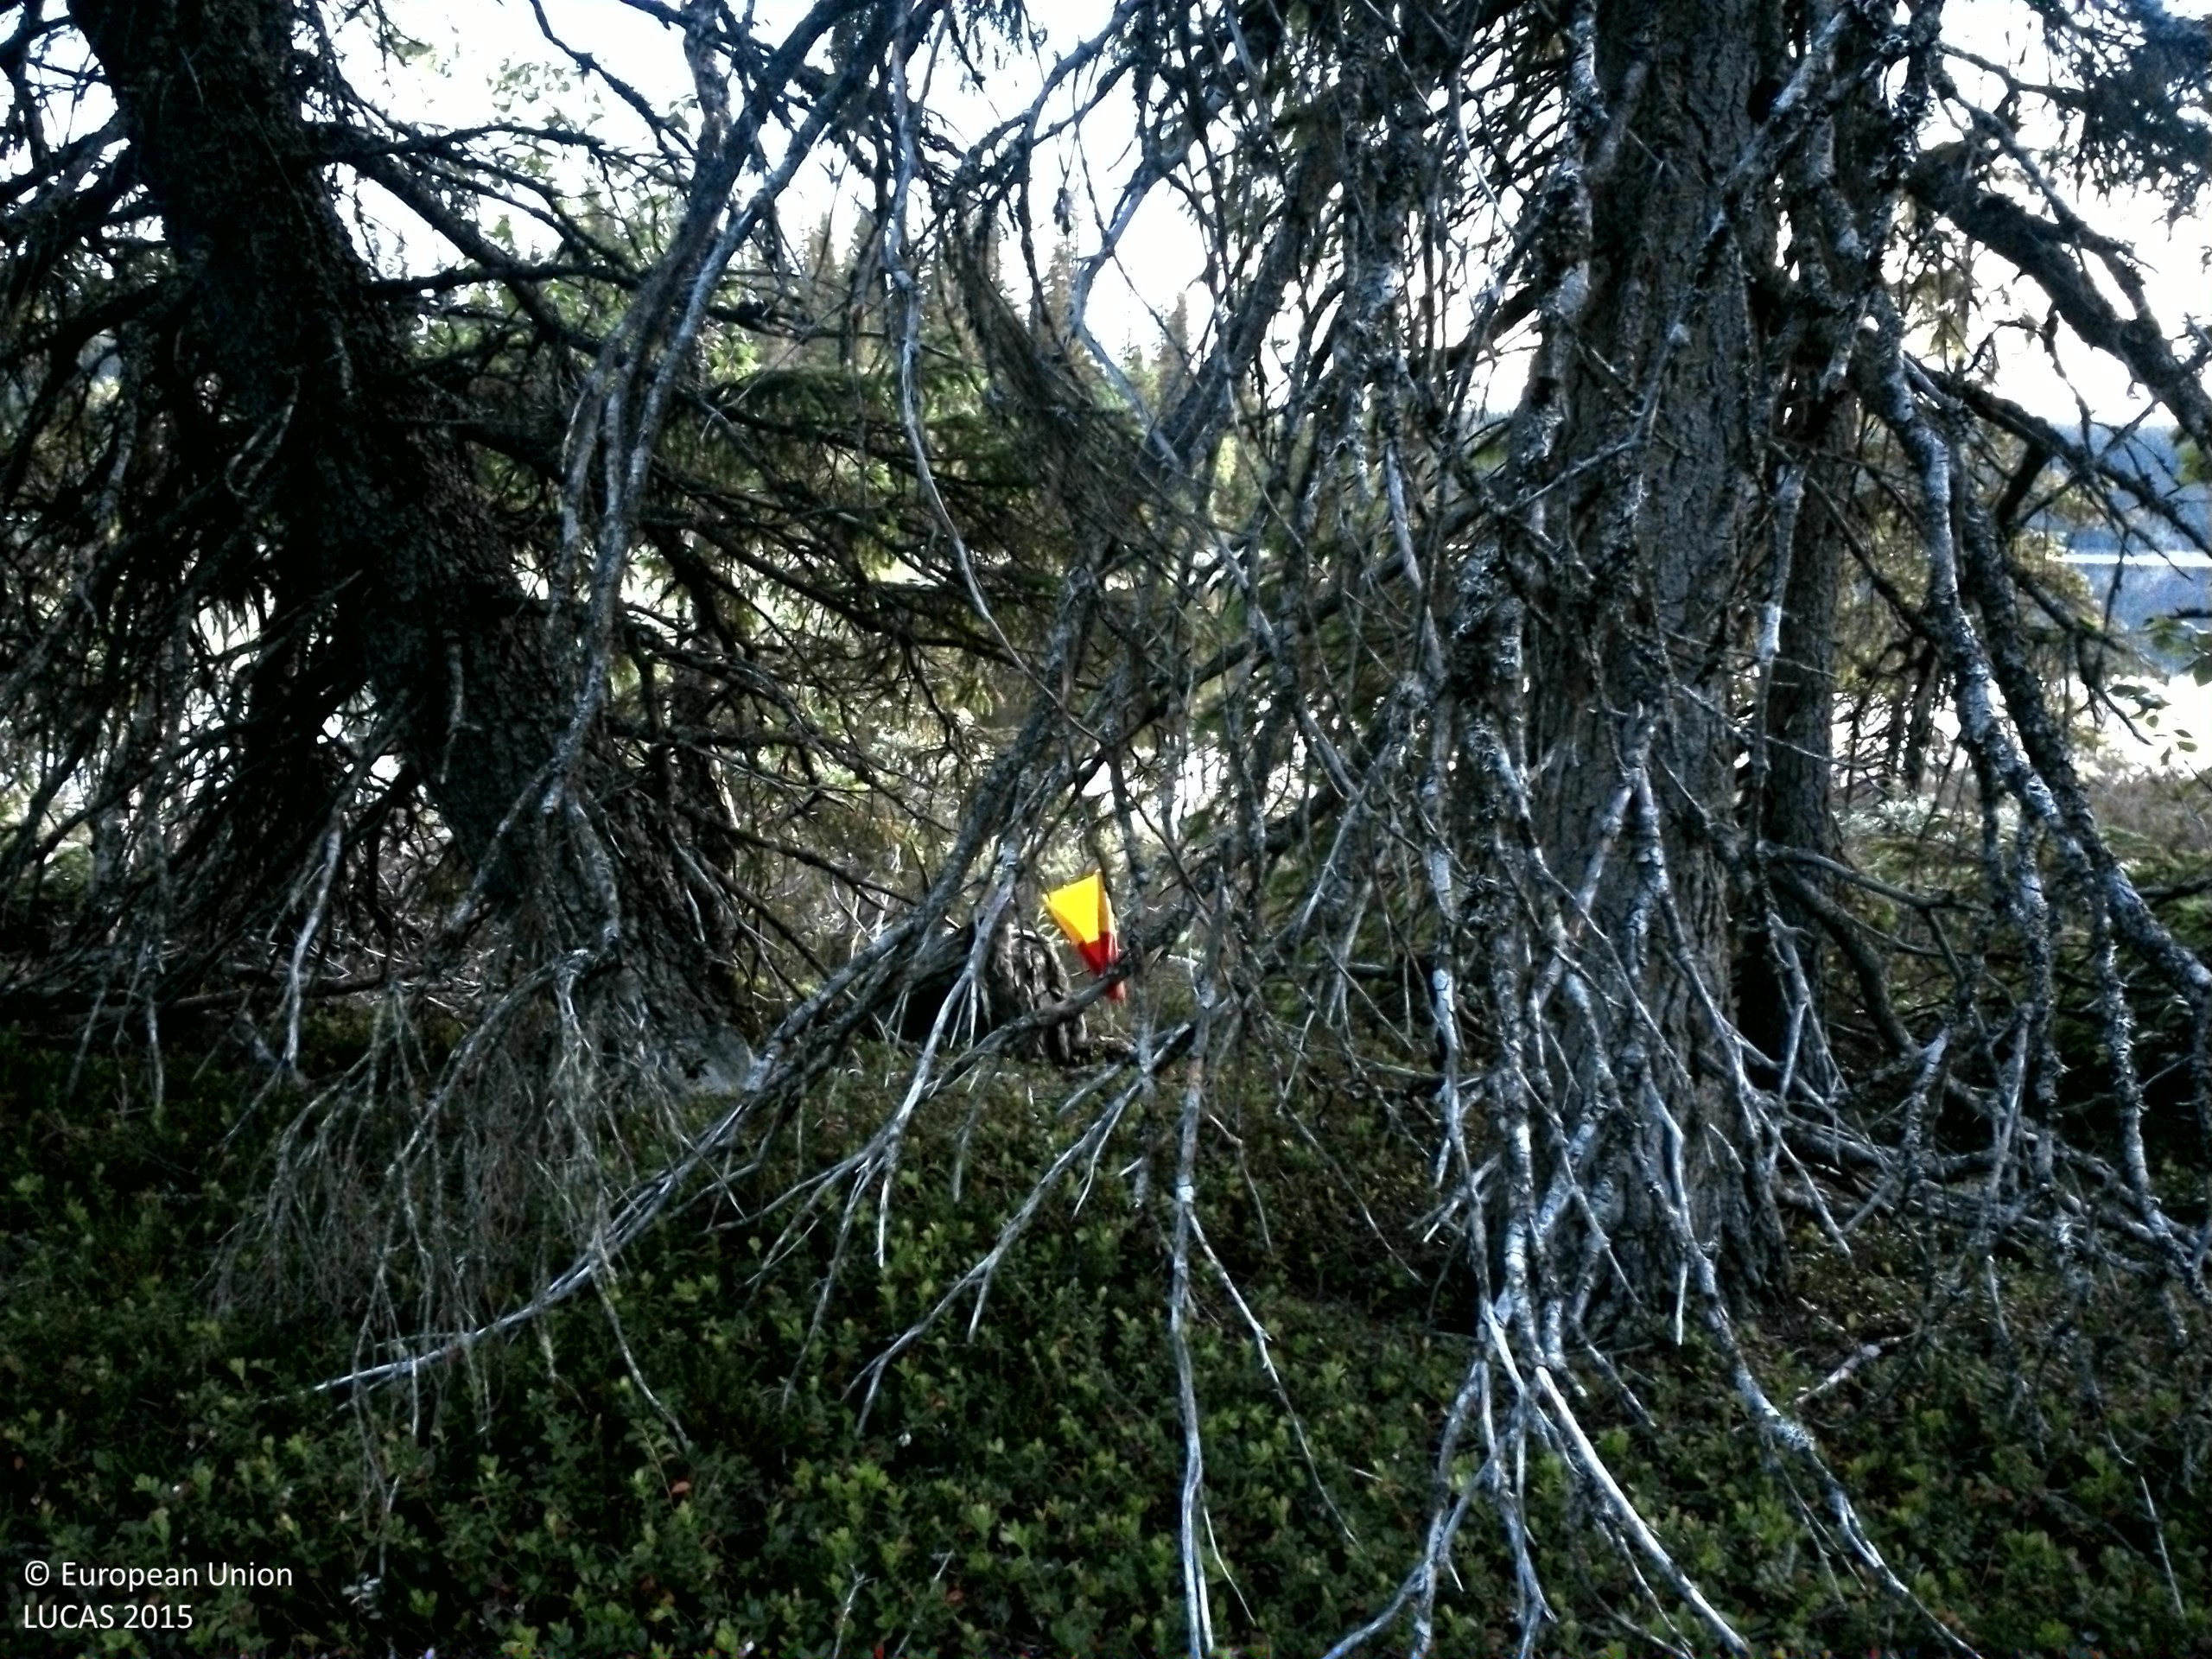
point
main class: Woodland
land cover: Spruce dominated mixed woodland
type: boreal forest
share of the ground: 50 - 75 %
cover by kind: coniferous forest trees 35 %, shrubs 35 %, broadleaved forest trees 15 %, herbaceous plants 10 %, consolidated bare surface 5 %
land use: Forestry
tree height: > 5 m
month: July
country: SE
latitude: 64.7792
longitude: 15.3327
